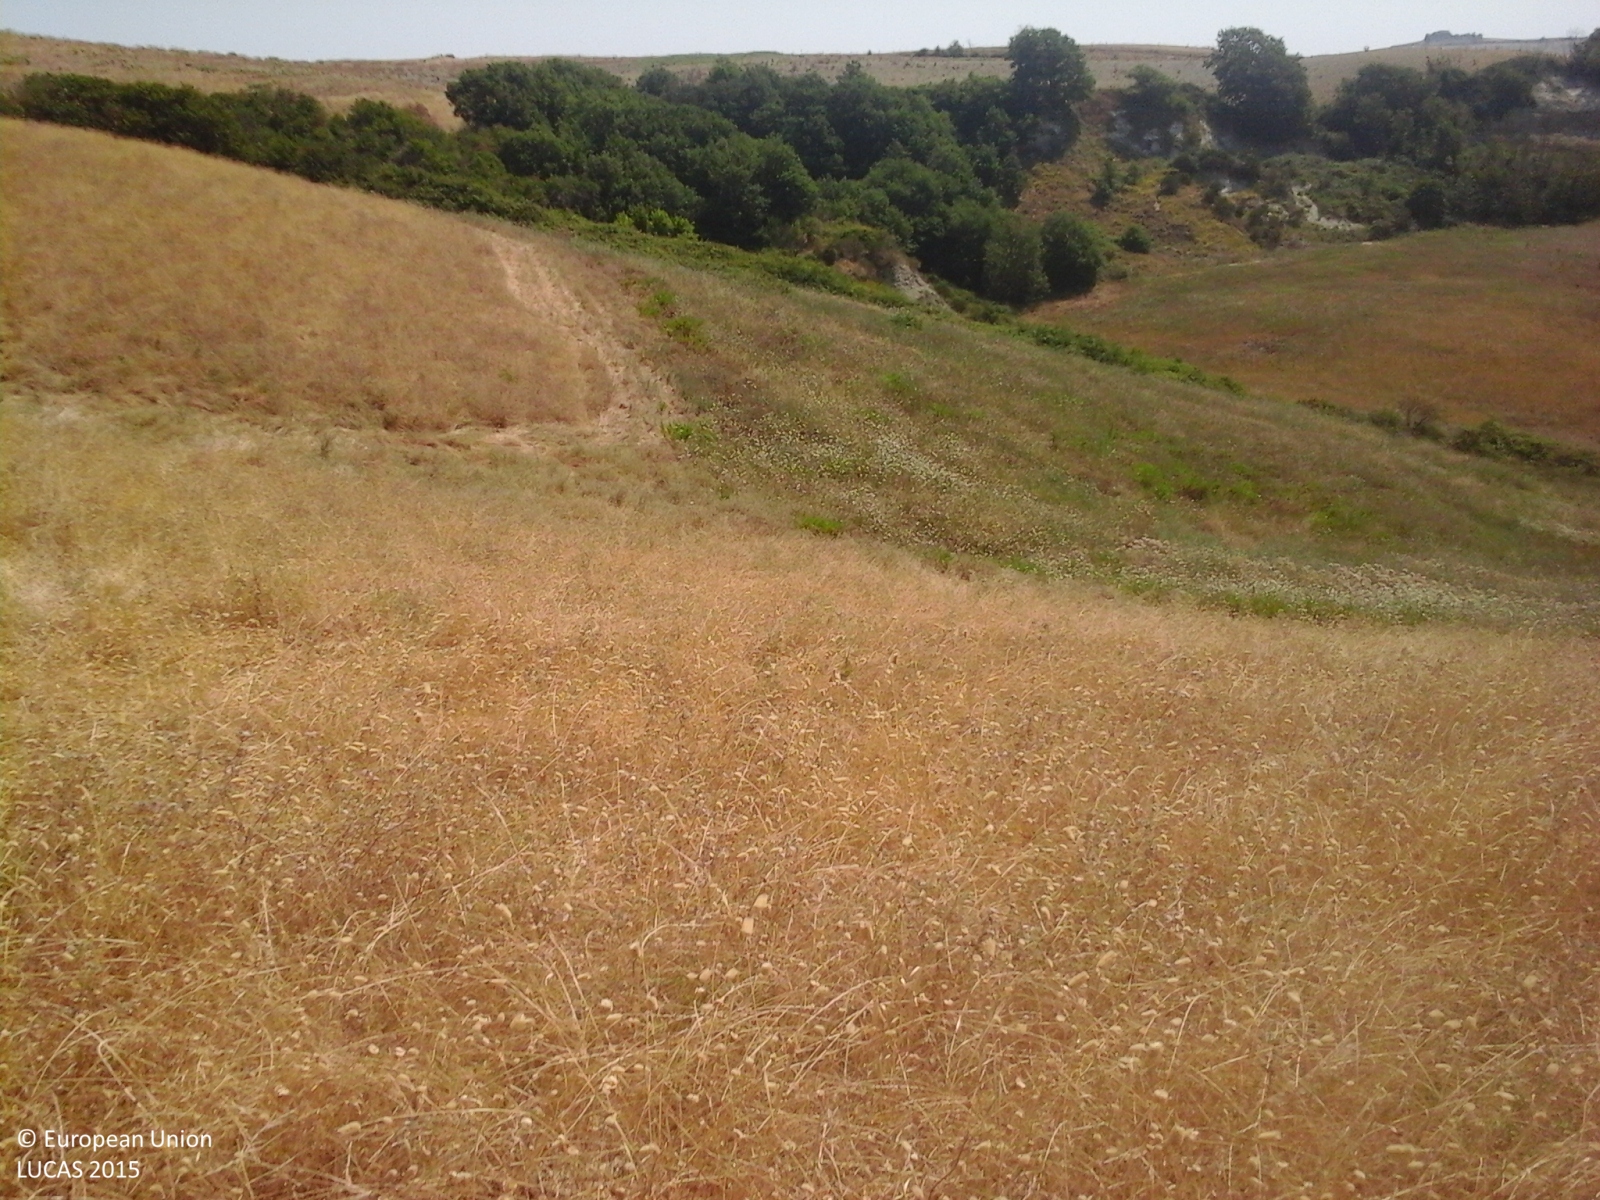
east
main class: Cropland
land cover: Temporary grasslands
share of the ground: > 75 %
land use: Agriculture (excluding fallow land and kitchen gardens)
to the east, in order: Temporary grasslands; Abandoned hedges; Grassland without tree/shrub cover; Shrubland without tree cover
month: July
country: IT
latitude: 43.1120
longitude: 11.5315
